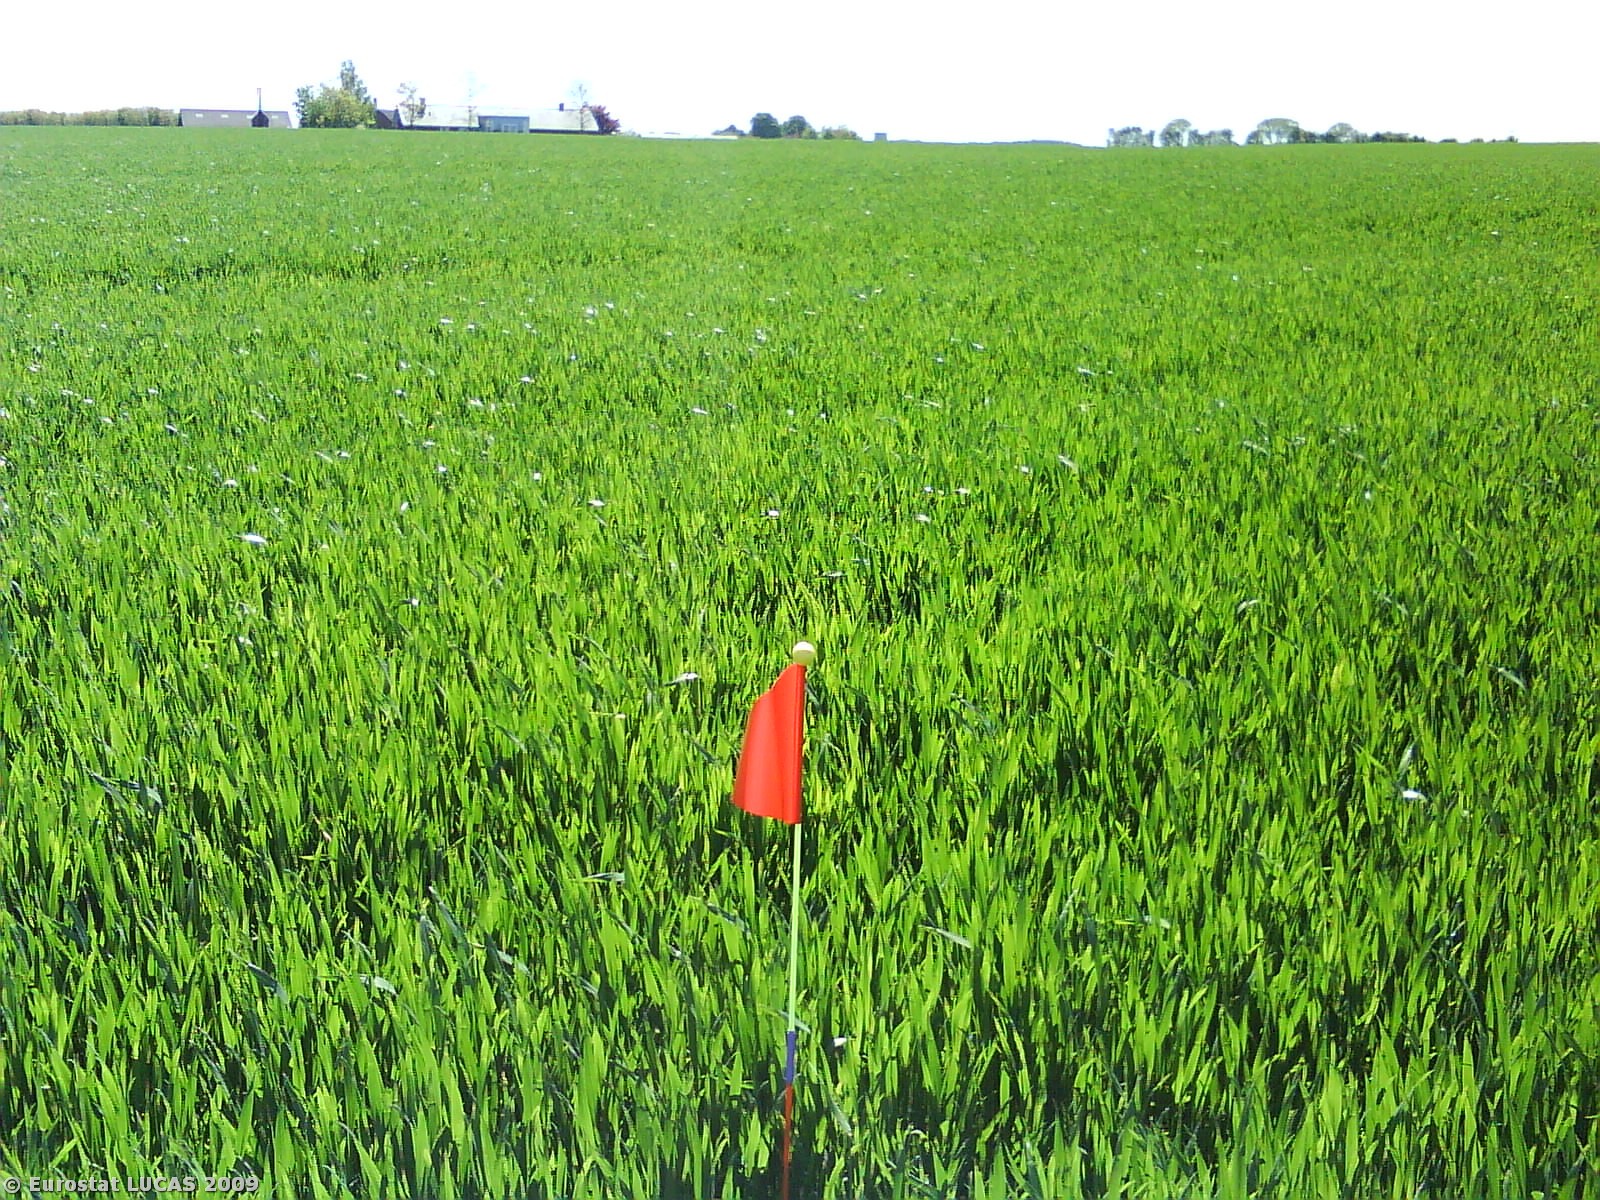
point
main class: Cropland
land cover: Common wheat
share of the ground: > 75 %
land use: Agriculture (excluding fallow land and kitchen gardens)
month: May
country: DK
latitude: 56.4723
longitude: 10.8917
